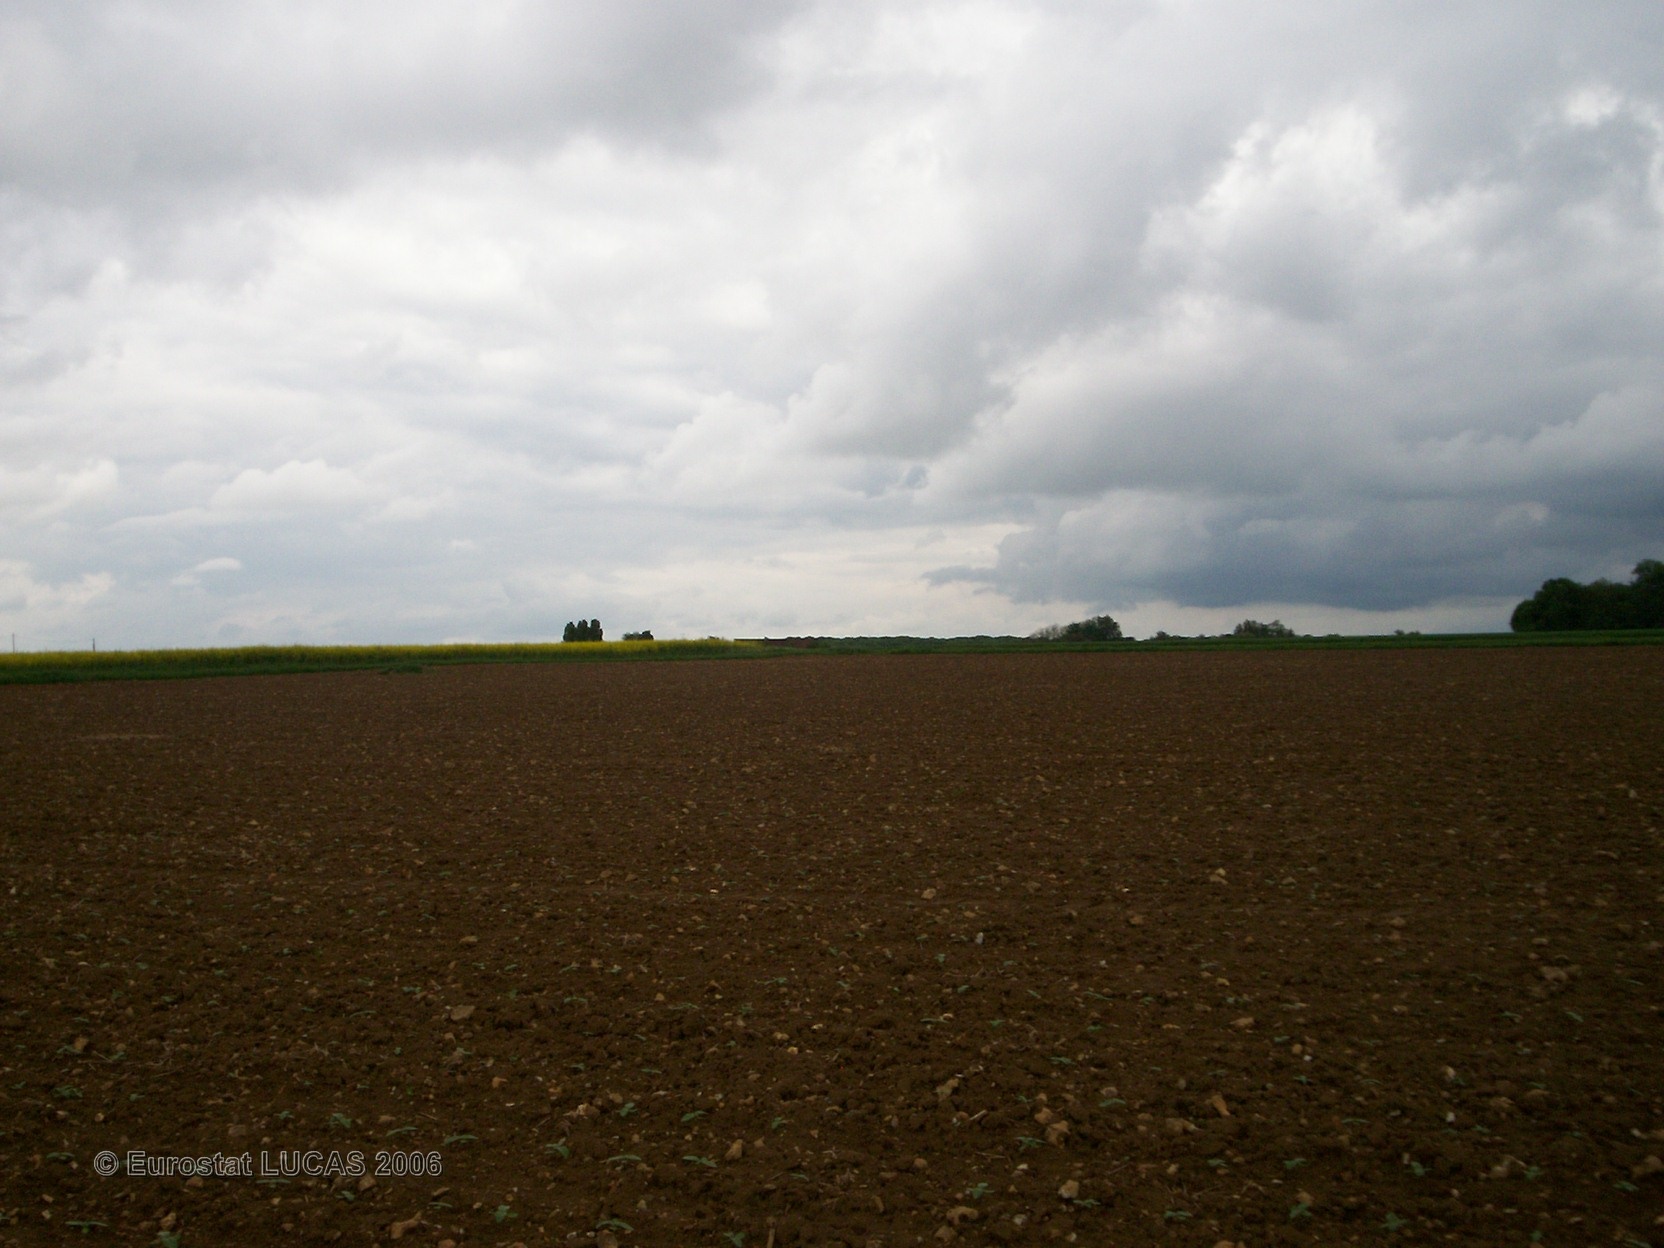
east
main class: Cropland
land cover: Sunflower
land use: Agriculture (excluding fallow land and kitchen gardens)
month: May
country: FR
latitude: 48.0178
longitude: 2.9809
